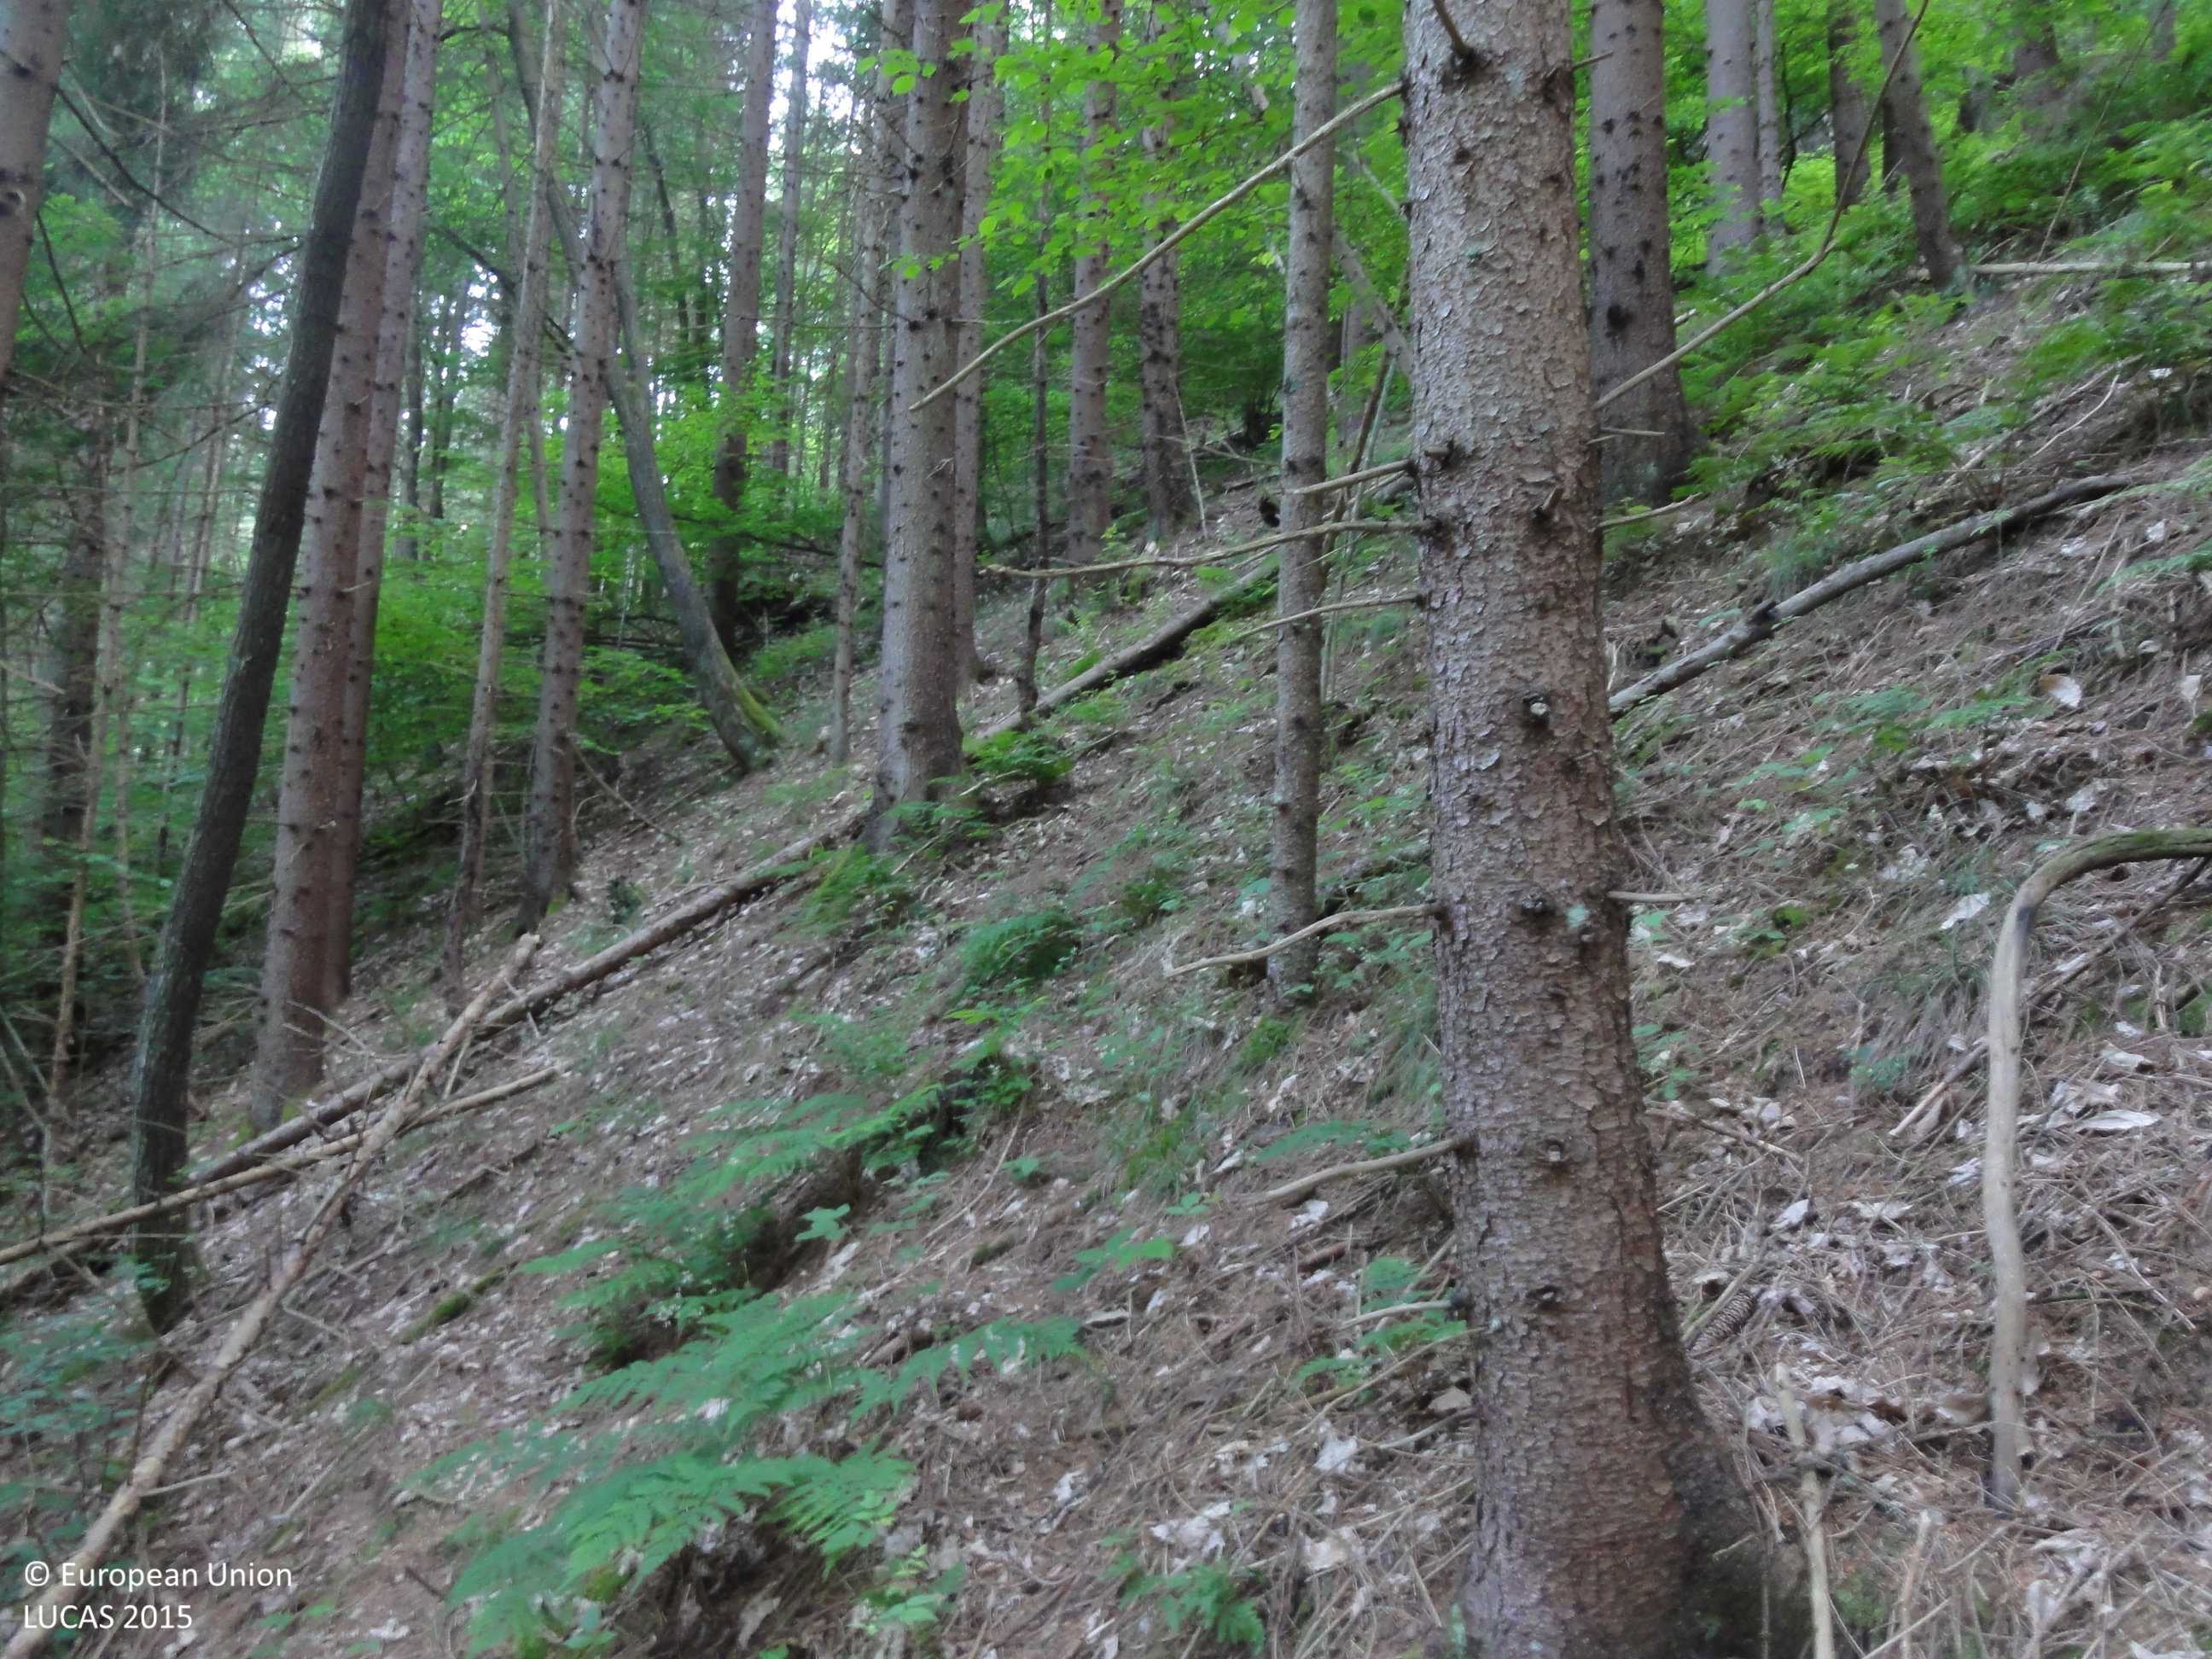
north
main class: Woodland
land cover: Spruce dominated mixed woodland
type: alpine coniferous forest
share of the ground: > 75 %
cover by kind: coniferous forest trees 60 %, broadleaved forest trees 35 %, shrubs 5 %
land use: Forestry
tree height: > 5 m
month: June
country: SI
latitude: 46.5810
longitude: 14.9177
